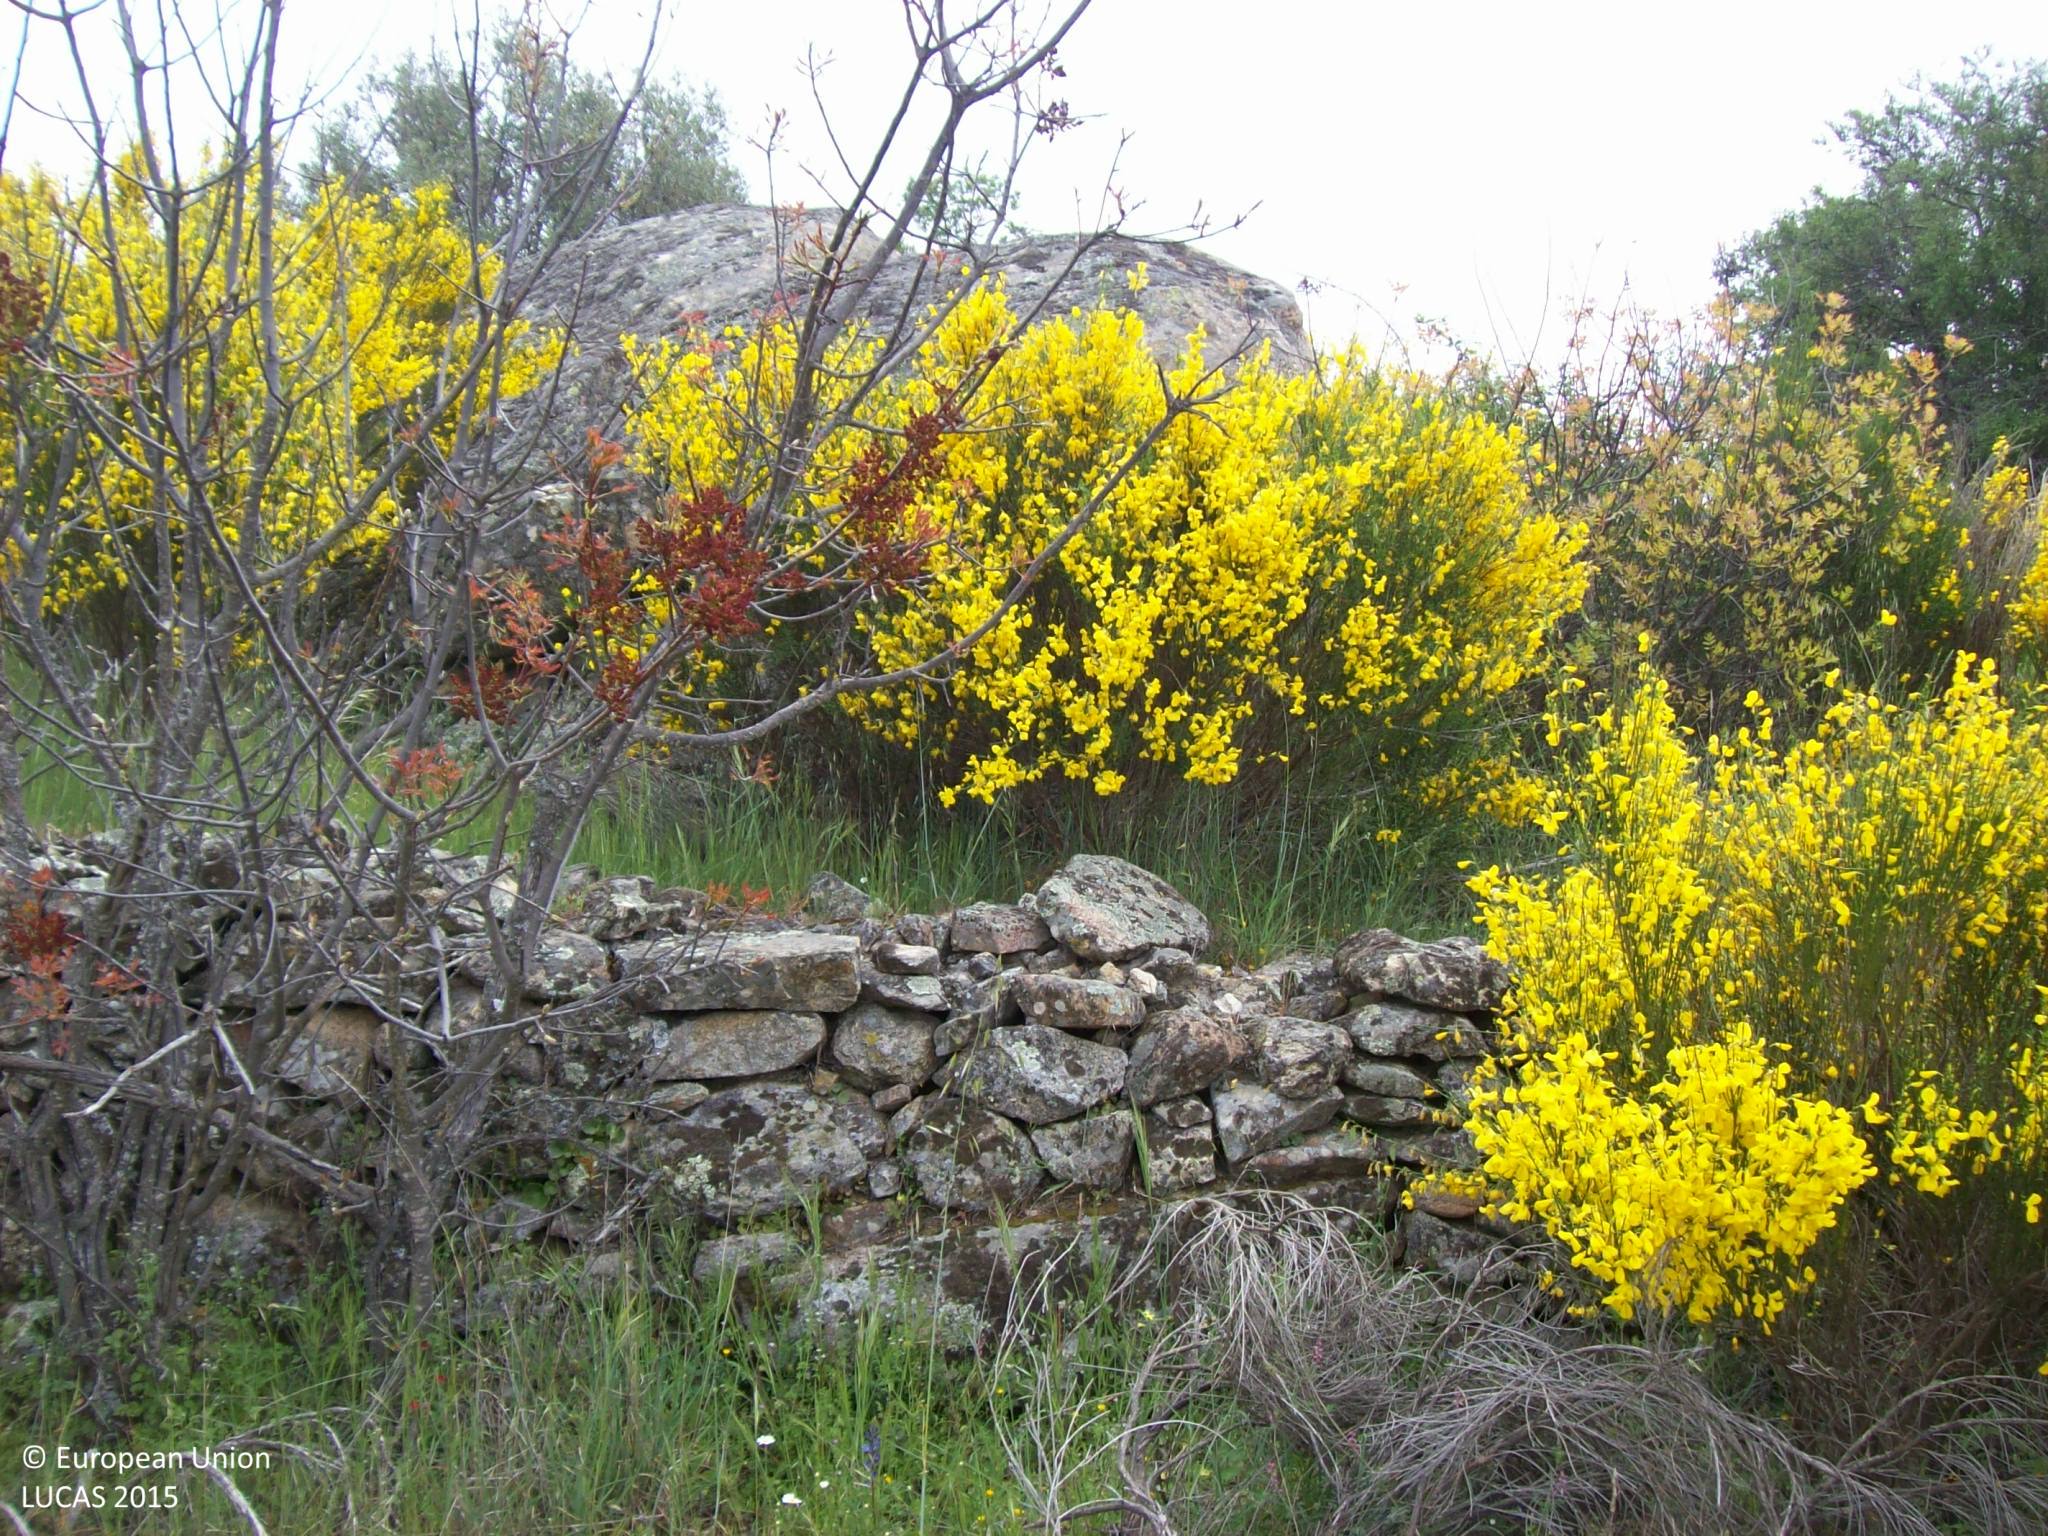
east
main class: Shrubland
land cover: Shrubland with sparse tree cover
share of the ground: 25 - 50 %
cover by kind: herbaceous plants 50 %, shrubs 35 %, broadleaved forest trees 5 %, consolidated bare surface 5 %
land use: Abandoned areas
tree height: < 5 m
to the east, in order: Shrubland with sparse tree cover; Dry stone walls; Rock outcrops; Tracks; Shrubland with sparse tree cover; Rock outcrops; Tracks; Rock outcrops; Tracks; Rock outcrops; Tracks; Shrubland with sparse tree cover
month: April
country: ES
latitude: 40.4574
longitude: -4.4472
